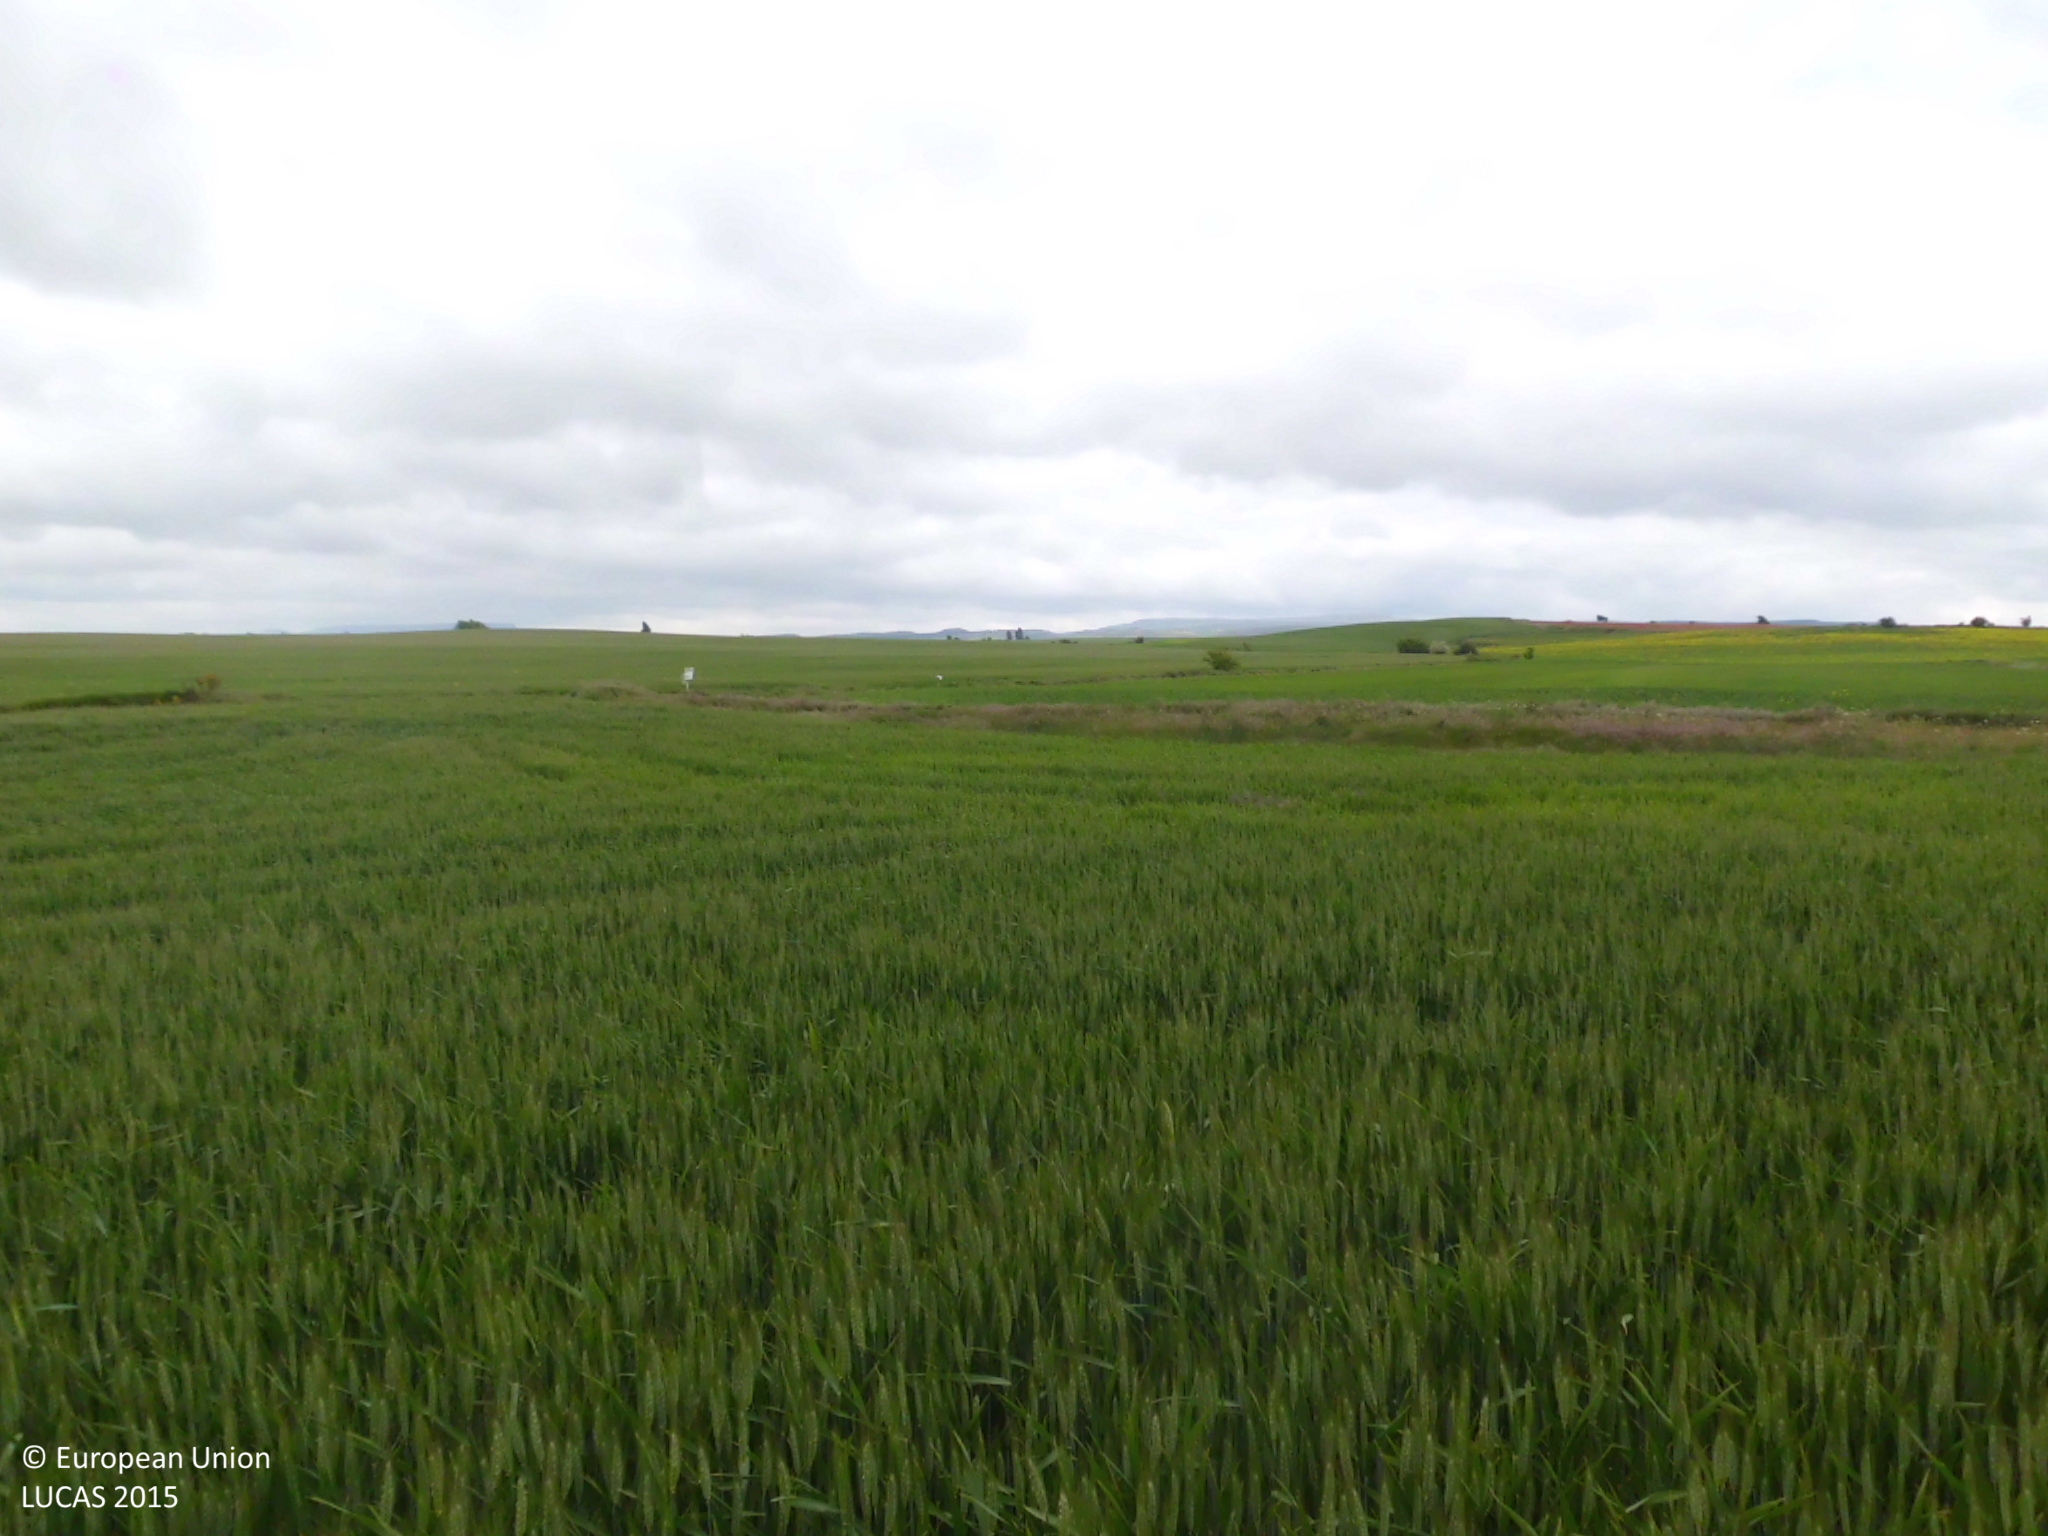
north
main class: Cropland
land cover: Barley
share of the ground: > 75 %
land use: Agriculture (excluding fallow land and kitchen gardens)
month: May
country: ES
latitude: 42.5352
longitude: -4.0083
